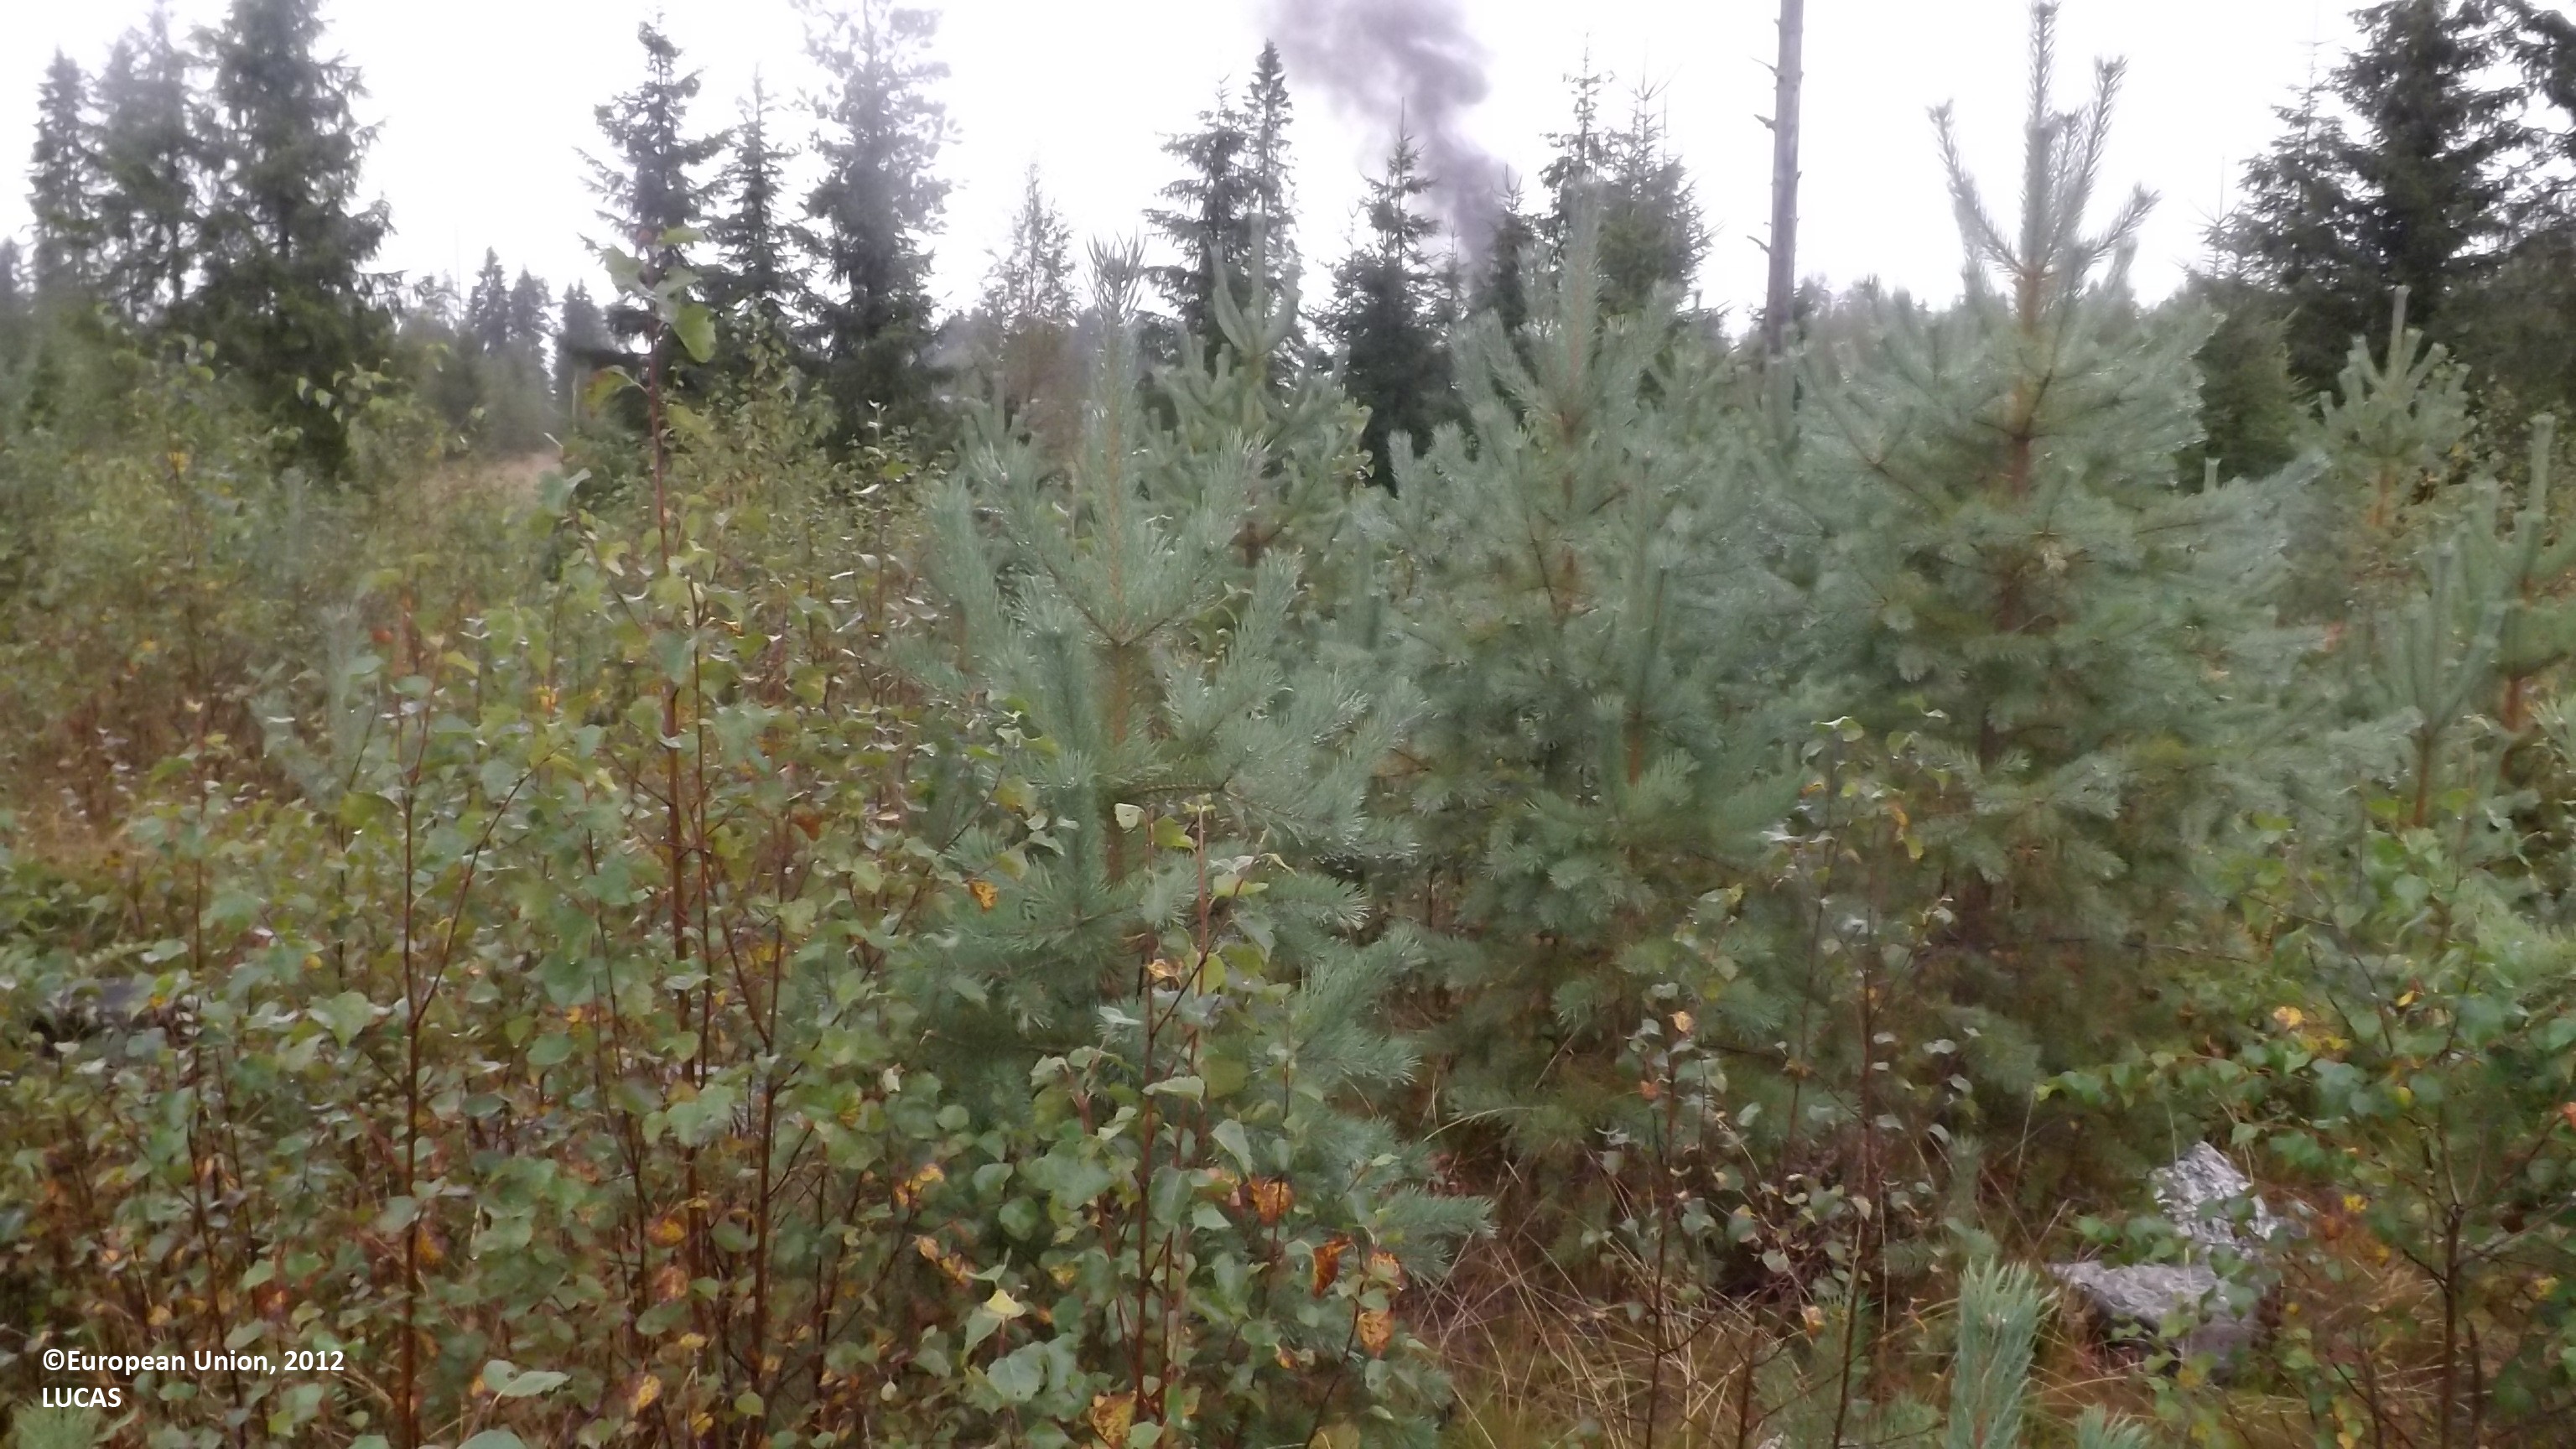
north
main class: Woodland
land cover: Pine dominated mixed woodland
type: boreal forest
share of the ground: 25 - 50 %
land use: Forestry
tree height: < 5 m
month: August
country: FI
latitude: 63.7700
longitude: 23.6283
